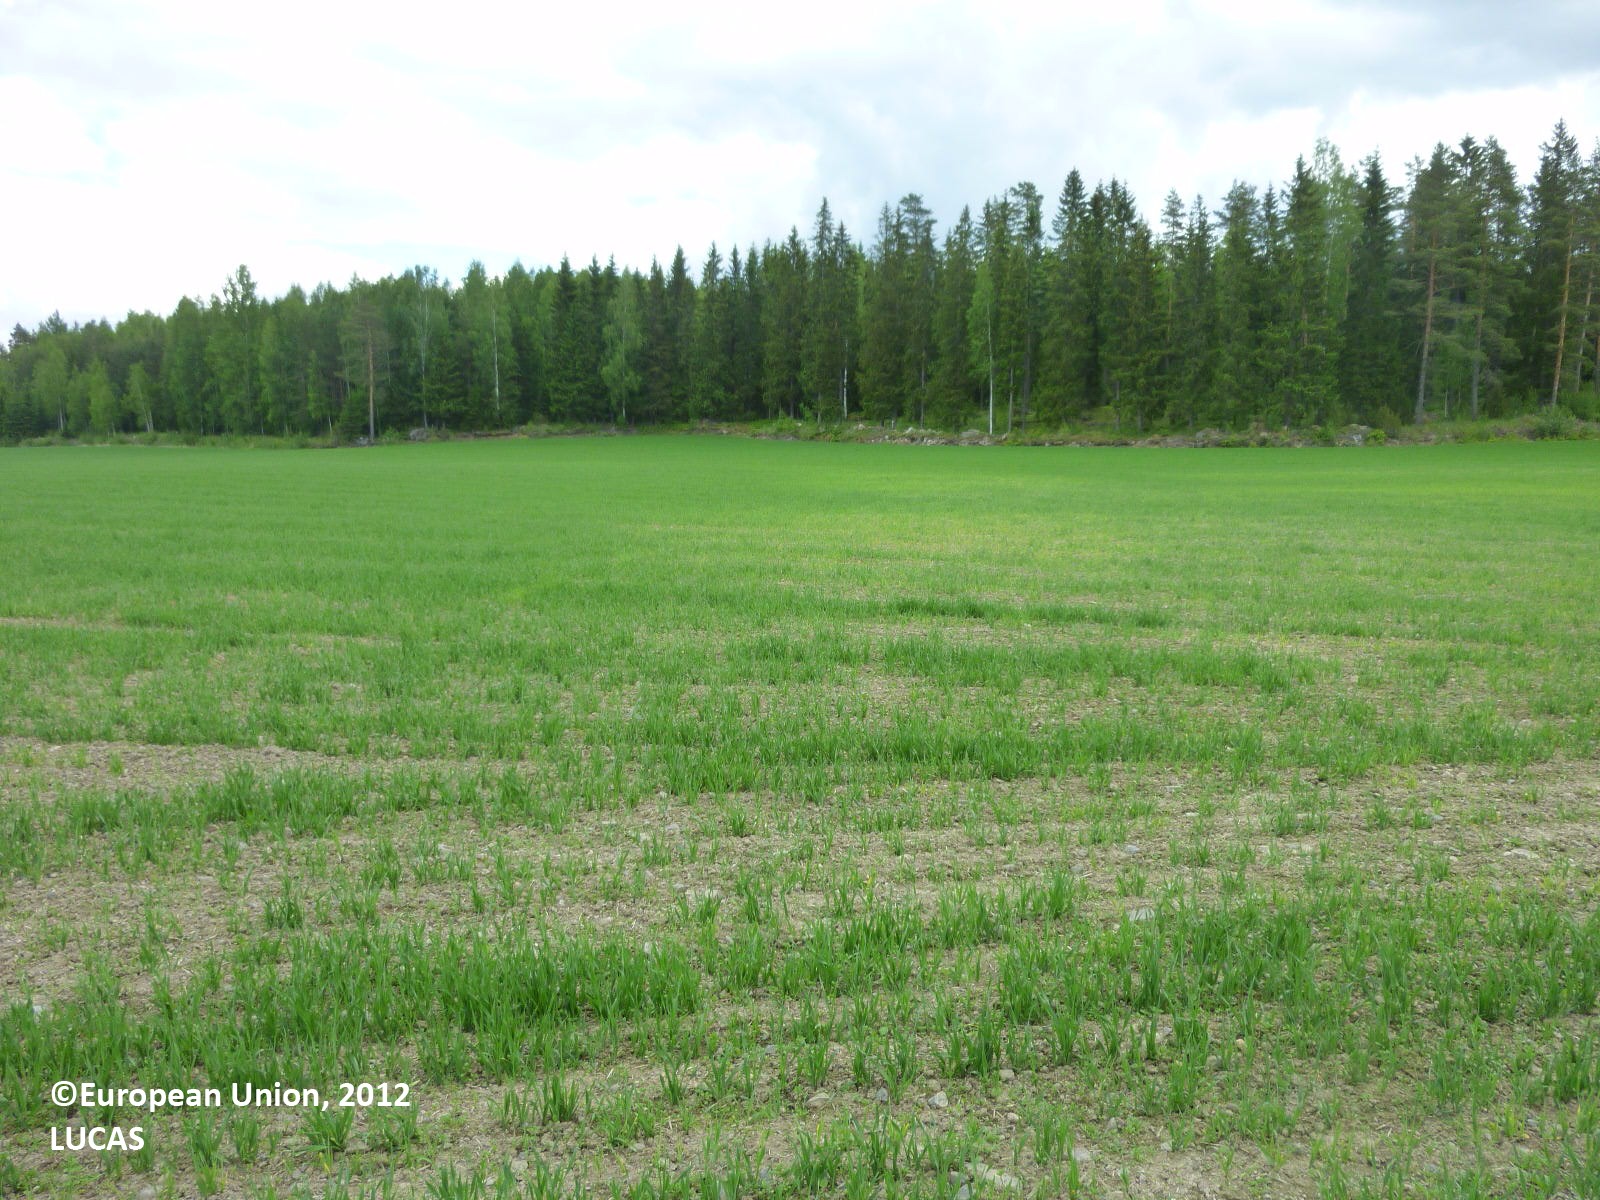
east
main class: Cropland
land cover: Barley
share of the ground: 50 - 75 %
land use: Agriculture (excluding fallow land and kitchen gardens)
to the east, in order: Barley; Grass margins; Ditches and canals; Spruce dominated mixed woodland; Grassland with sparse tree/shrub cover; Spruce dominated mixed woodland; Tracks; Spruce dominated coniferous woodland; Pine dominated mixed woodland; Spruce dominated coniferous woodland
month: June
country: FI
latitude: 61.4073
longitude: 22.5586
